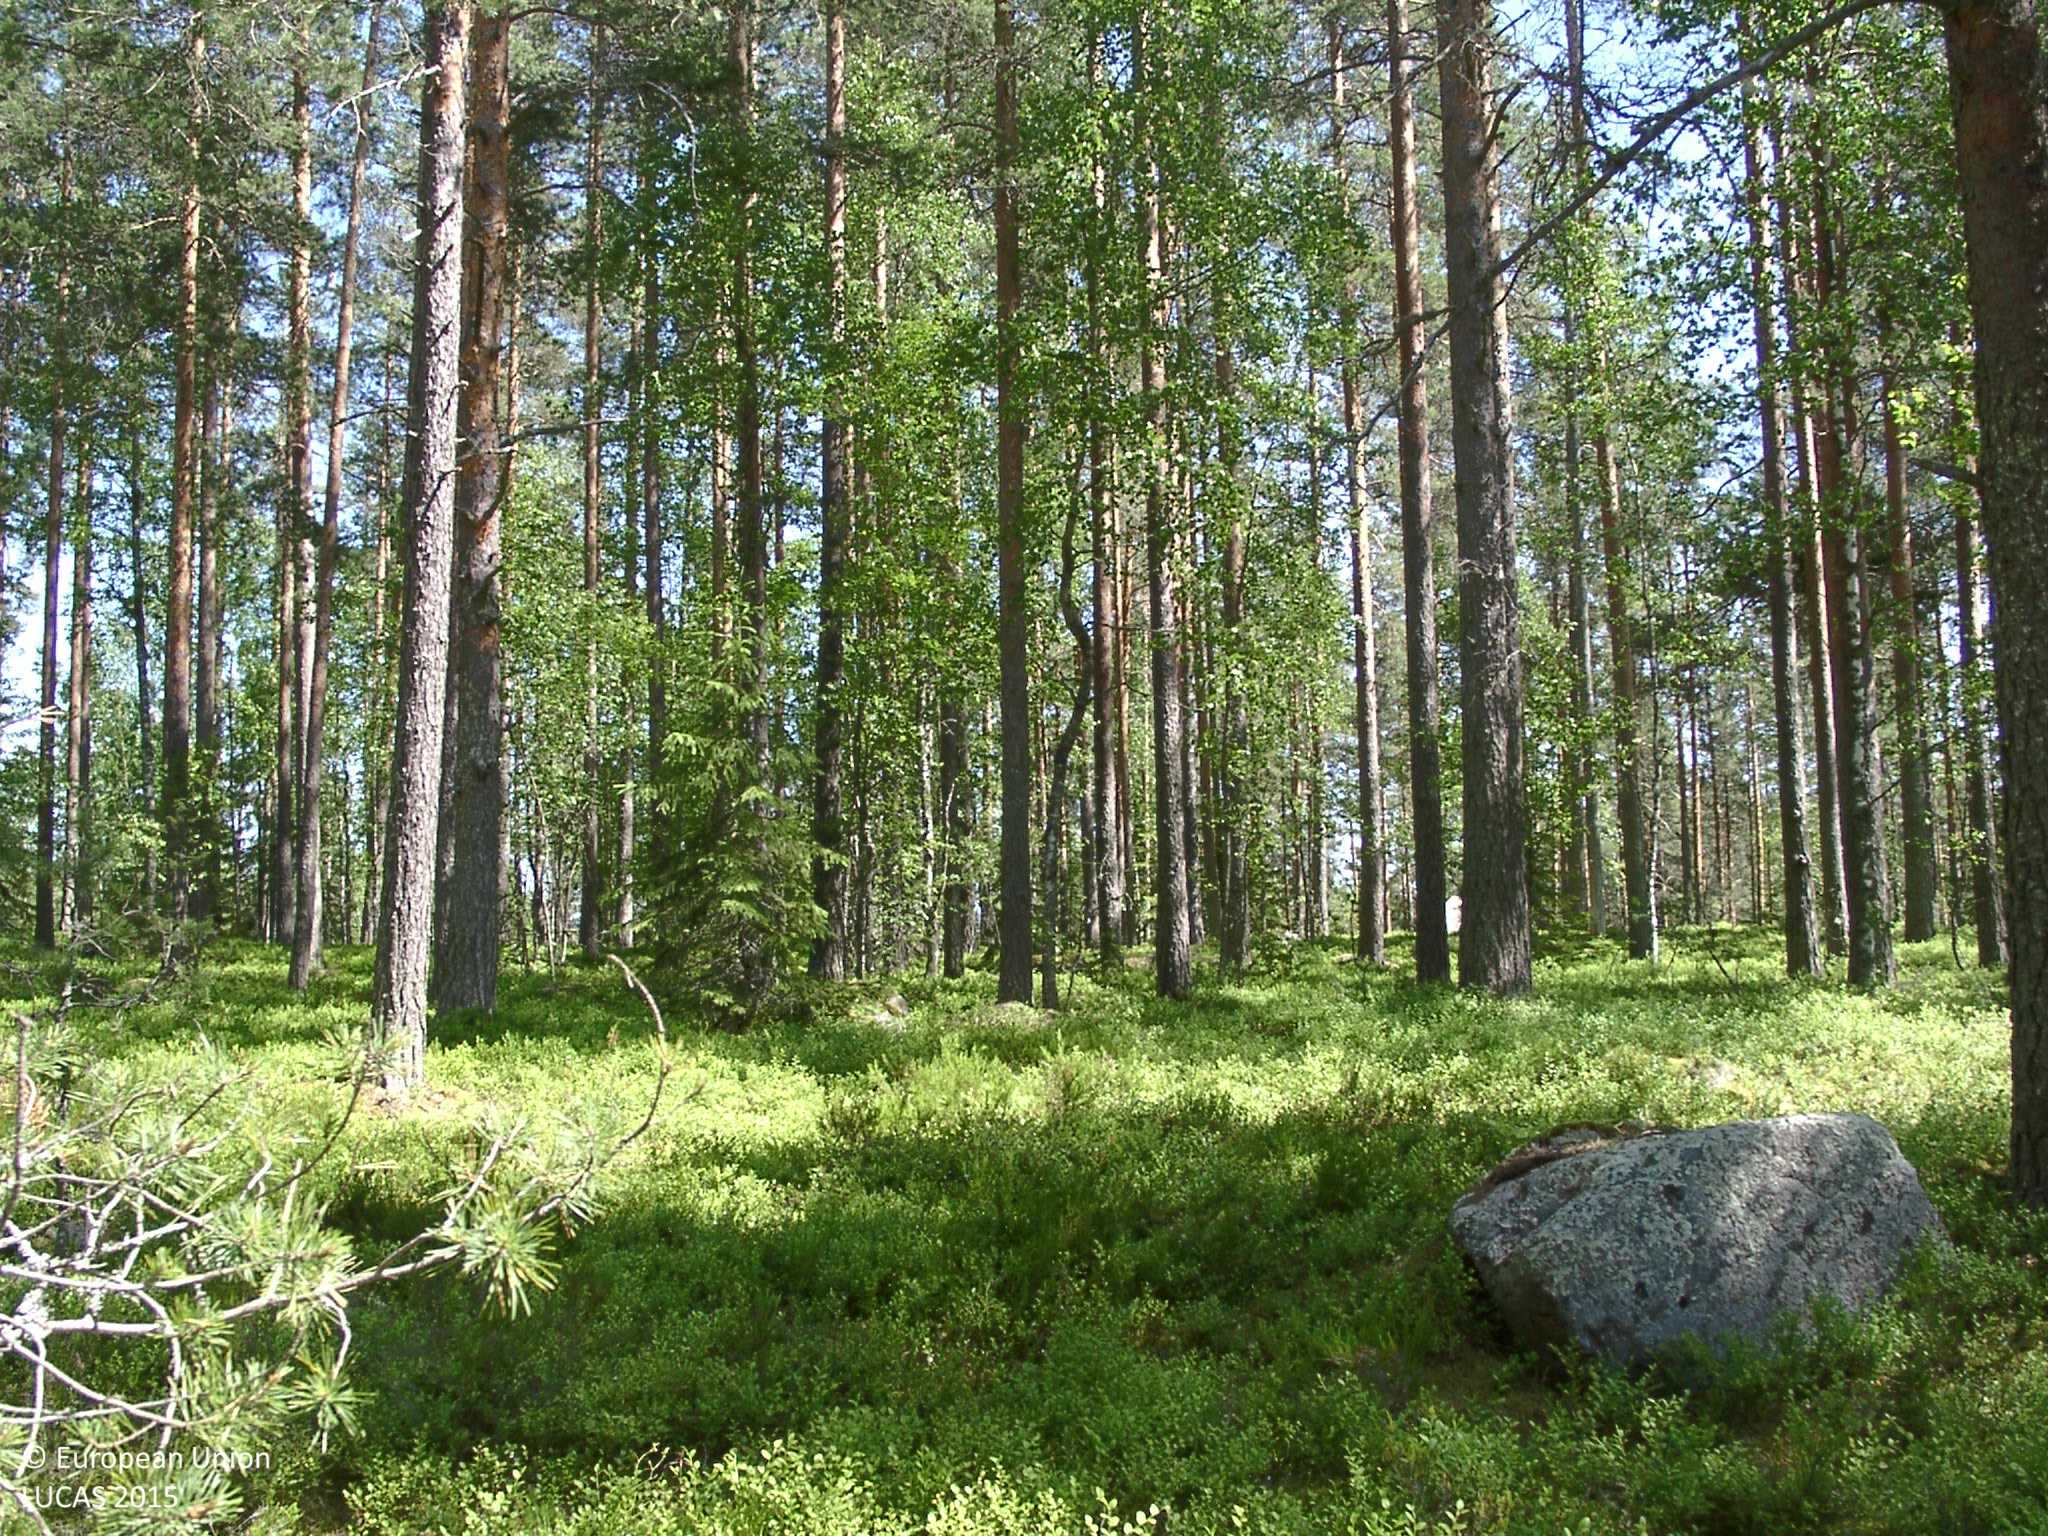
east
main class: Woodland
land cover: Pine dominated coniferous woodland
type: boreal forest
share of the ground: 50 - 75 %
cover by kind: coniferous forest trees 50 %, shrubs 30 %, lichens and mosses 10 %, broadleaved forest trees 5 %, consolidated bare surface 5 %
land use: Semi-natural and natural areas not in use
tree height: > 5 m
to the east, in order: Pine dominated coniferous woodland; Other coniferous woodland; Spruce dominated coniferous woodland
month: July
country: FI
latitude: 61.9808
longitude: 25.5553
